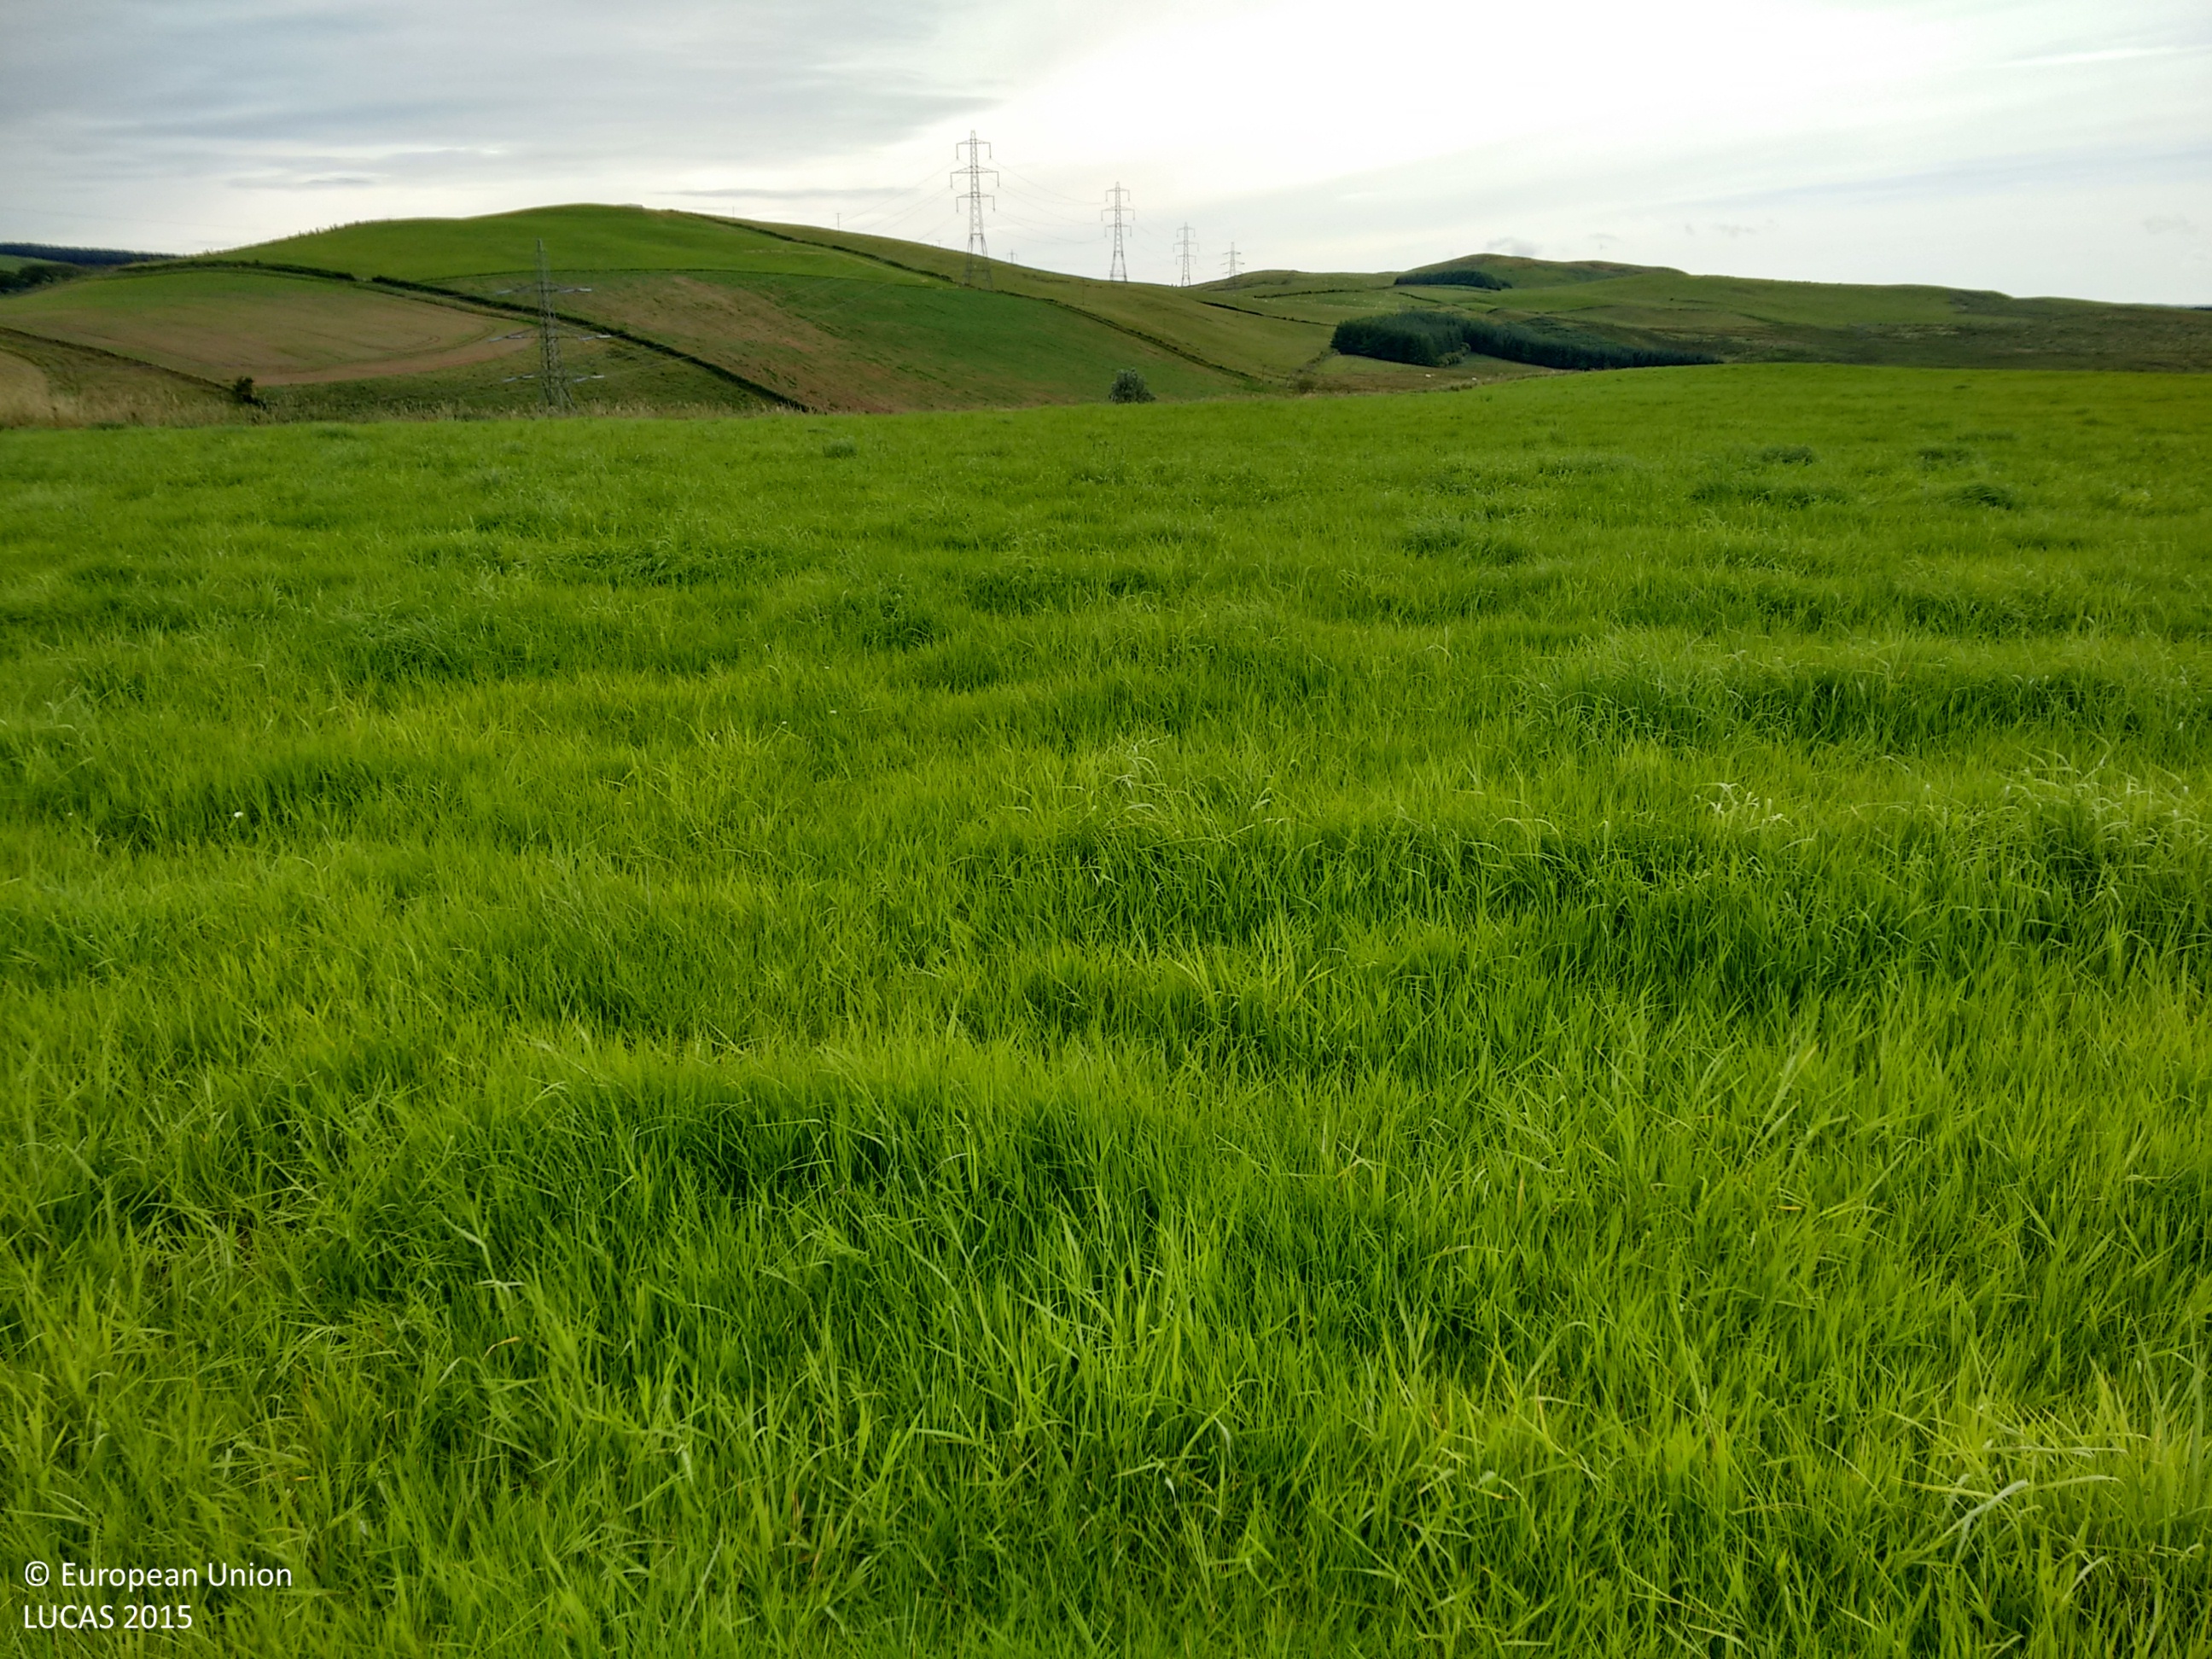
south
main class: Grassland
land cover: Grassland without tree/shrub cover
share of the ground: > 75 %
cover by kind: herbaceous plants 100 %
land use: Agriculture (excluding fallow land and kitchen gardens)
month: August
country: GB
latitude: 55.2291
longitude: -3.3630
